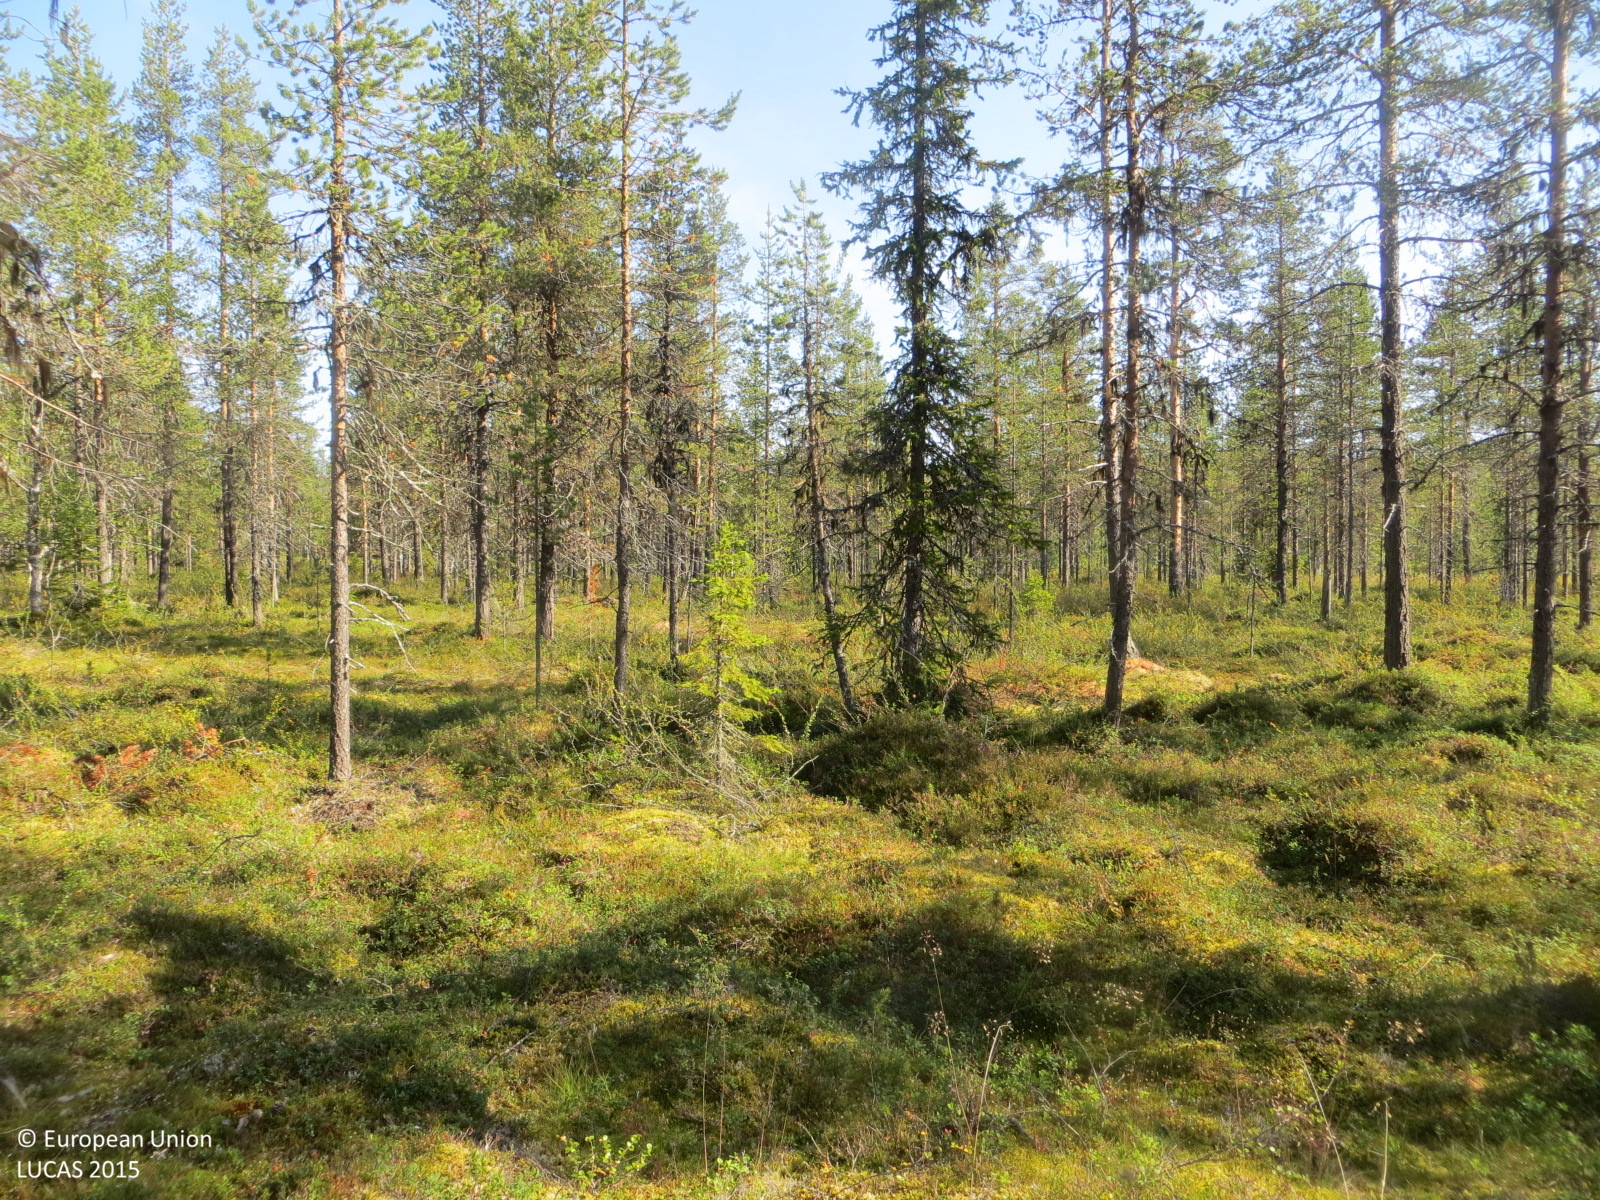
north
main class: Woodland
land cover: Pine dominated coniferous woodland
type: boreal forest
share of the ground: 50 - 75 %
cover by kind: coniferous forest trees 50 %, shrubs 50 %
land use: Forestry
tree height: > 5 m
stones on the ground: < 10 %
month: August
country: FI
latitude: 67.7104
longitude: 24.1264
